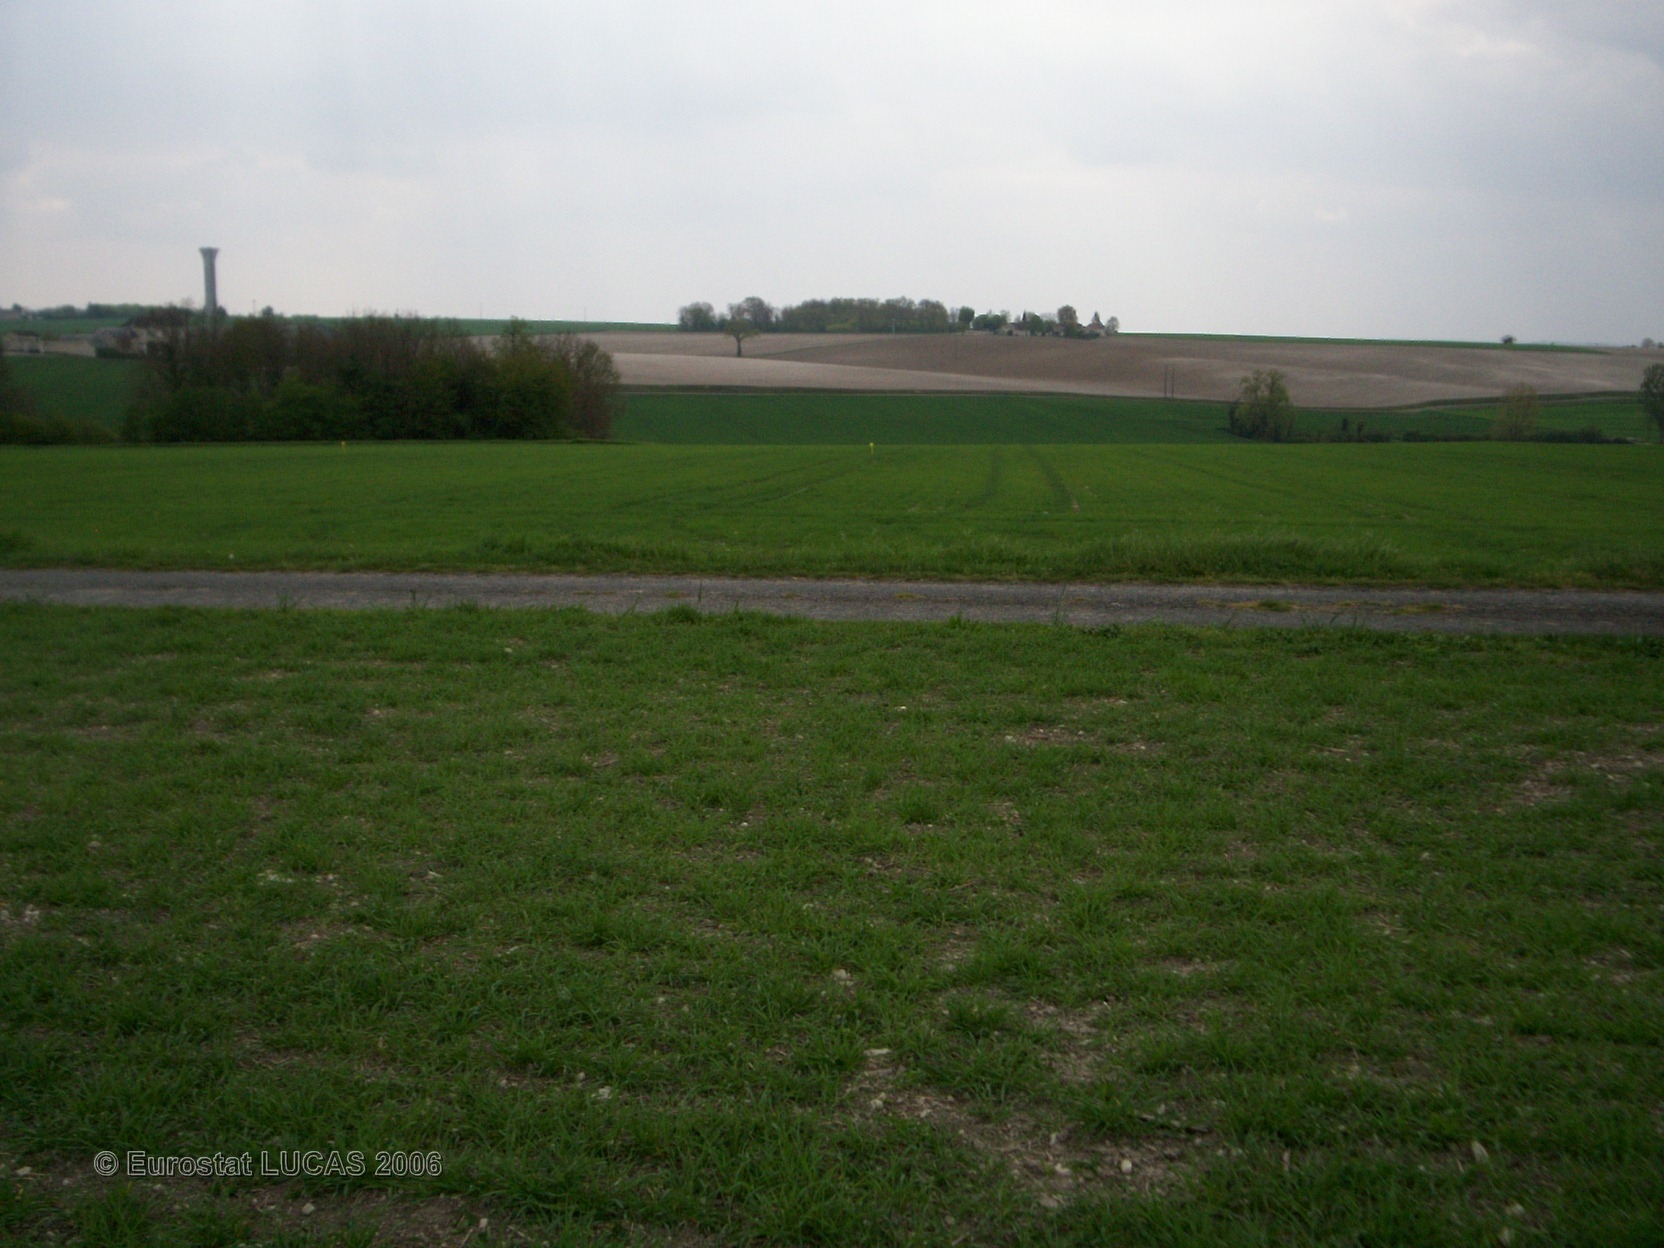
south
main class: Cropland
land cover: Barley
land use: Agriculture (excluding fallow land and kitchen gardens)
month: April
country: FR
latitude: 47.0900
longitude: 0.3227
